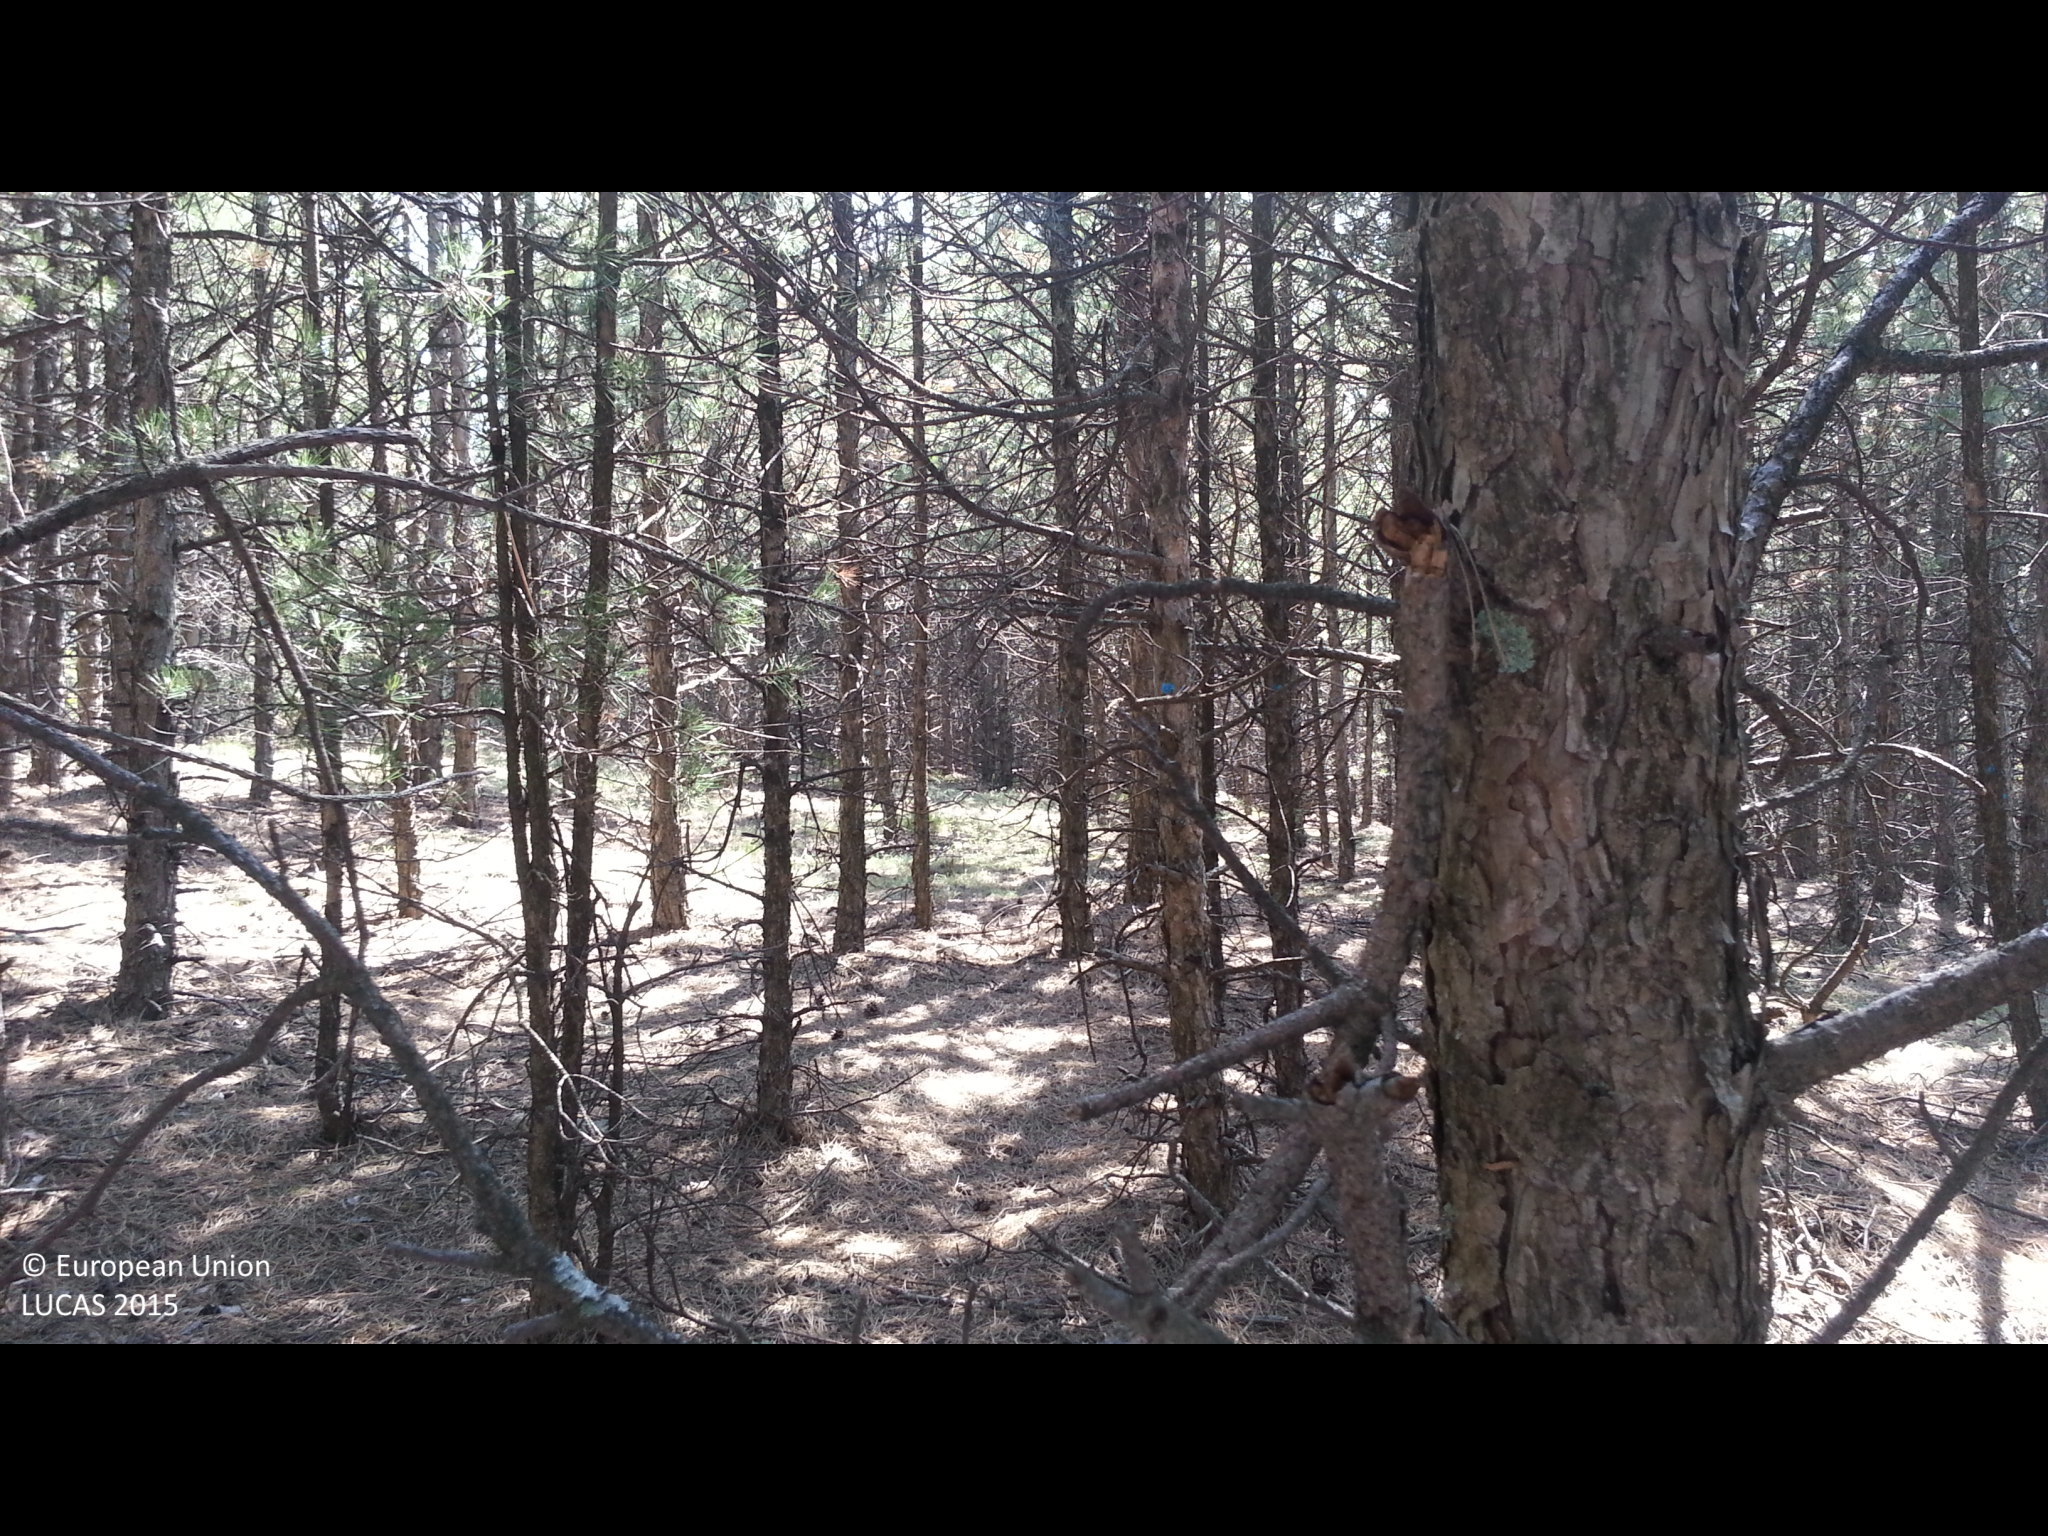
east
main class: Woodland
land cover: Pine dominated coniferous woodland
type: hemiboreal forest and nemoral coniferous forest and mixed broadleaved-coniferous forest
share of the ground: > 75 %
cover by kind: coniferous forest trees 100 %
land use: Forestry
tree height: > 5 m
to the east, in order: Pine dominated coniferous woodland; Grassland with sparse tree/shrub cover; Tracks; Grassland without tree/shrub cover; Rocks and stones; Grassland without tree/shrub cover; Pine dominated coniferous woodland; Broadleaved woodland
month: August
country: BG
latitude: 42.5069
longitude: 23.1367
